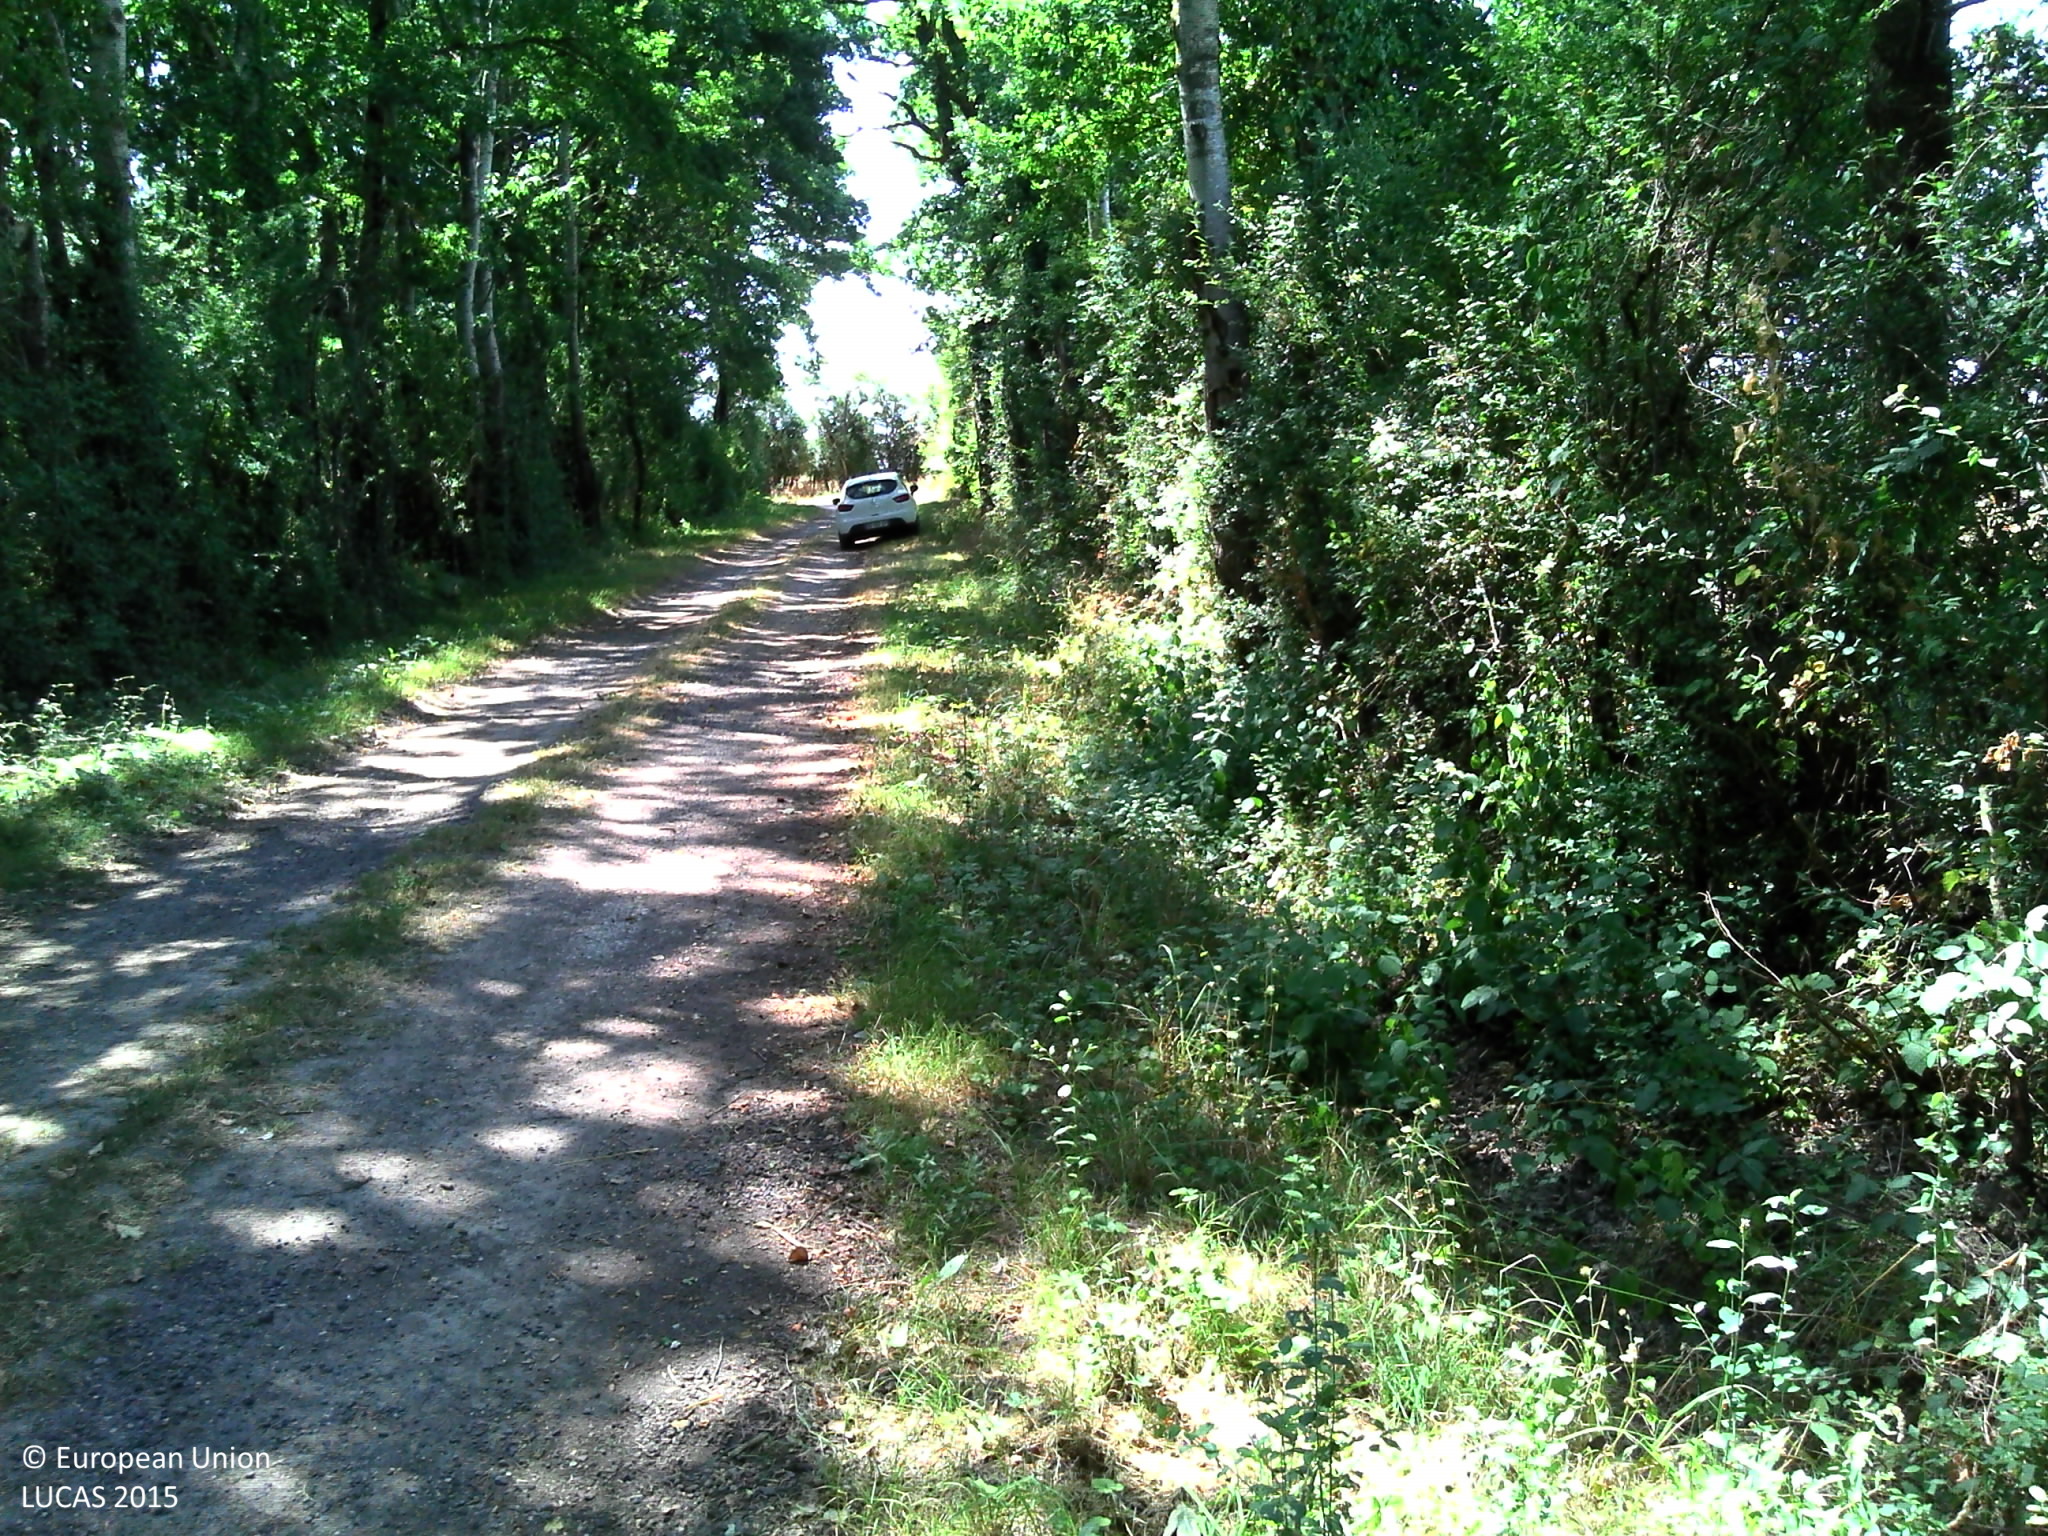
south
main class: Grassland
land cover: Grassland without tree/shrub cover
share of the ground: > 75 %
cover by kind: herbaceous plants 100 %
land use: Agriculture (excluding fallow land and kitchen gardens)
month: July
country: FR
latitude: 46.2073
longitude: 0.5878
